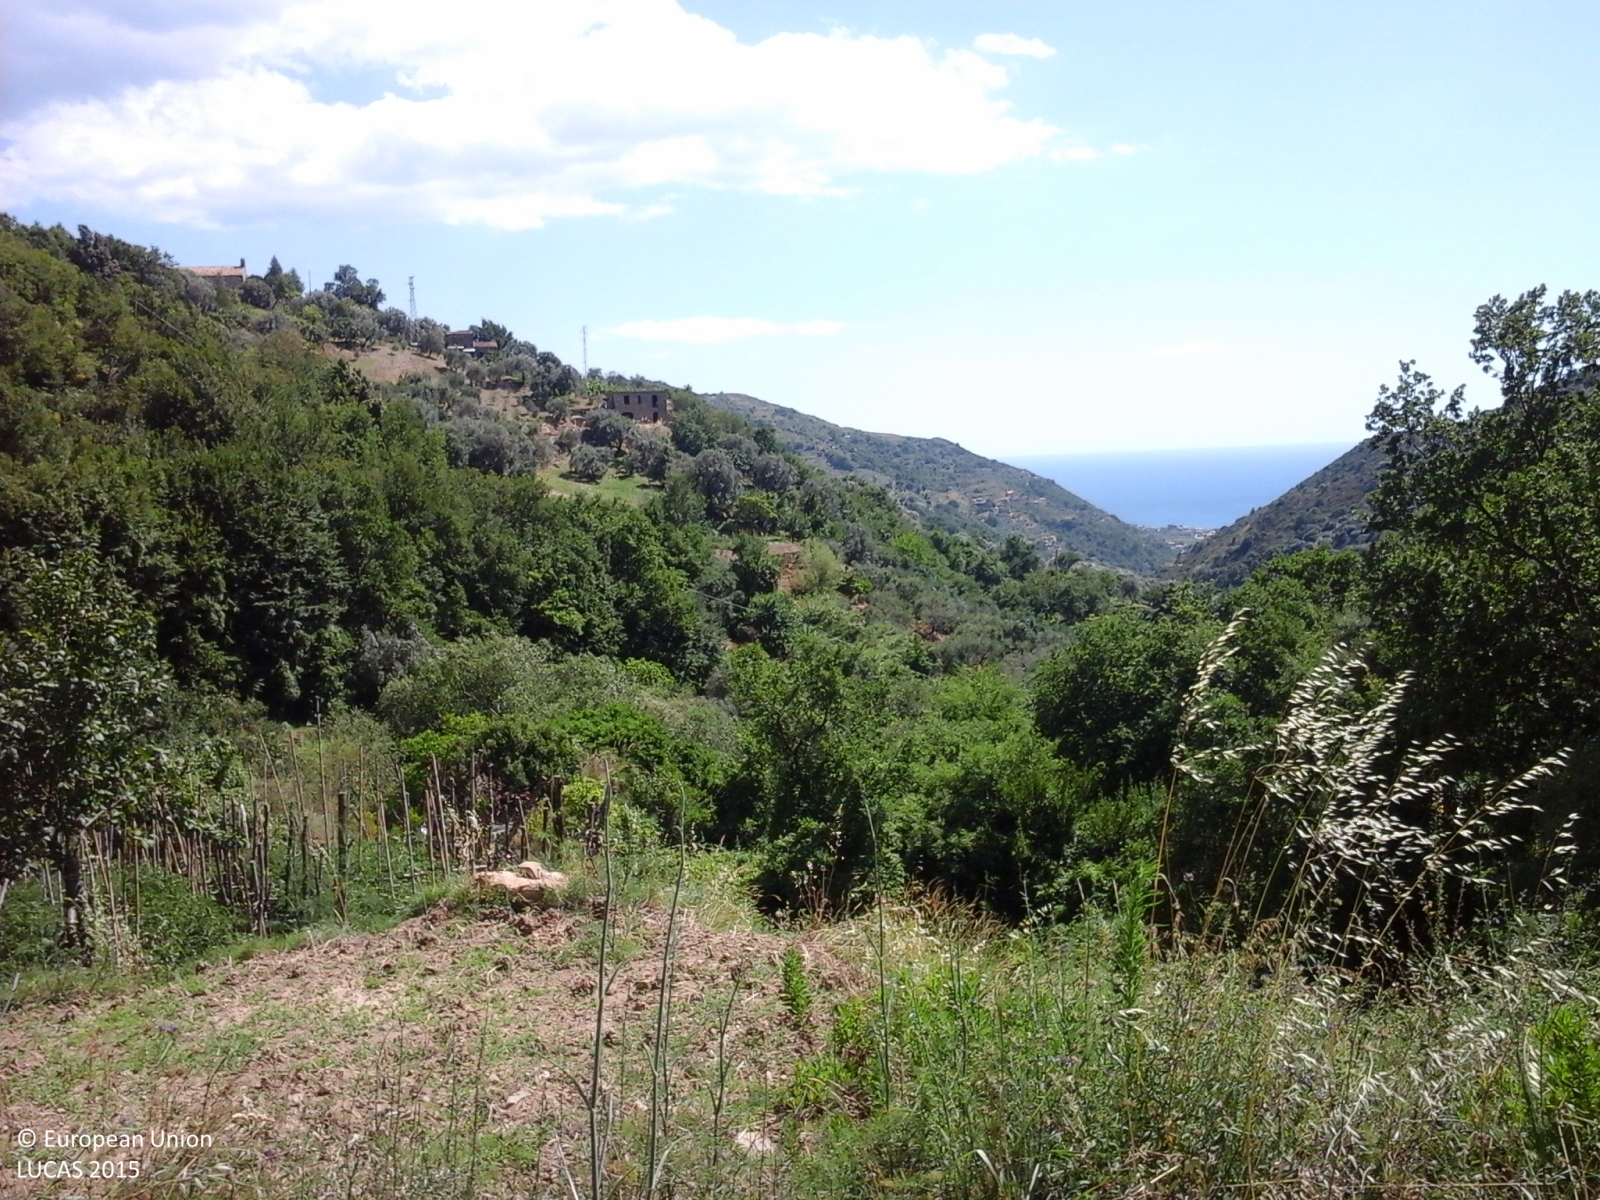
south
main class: Shrubland
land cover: Shrubland with sparse tree cover
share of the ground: > 75 %
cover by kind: shrubs 95 %, broadleaved forest trees 5 %
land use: Semi-natural and natural areas not in use
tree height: > 5 m
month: June
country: IT
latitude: 40.2475
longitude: 15.0208
